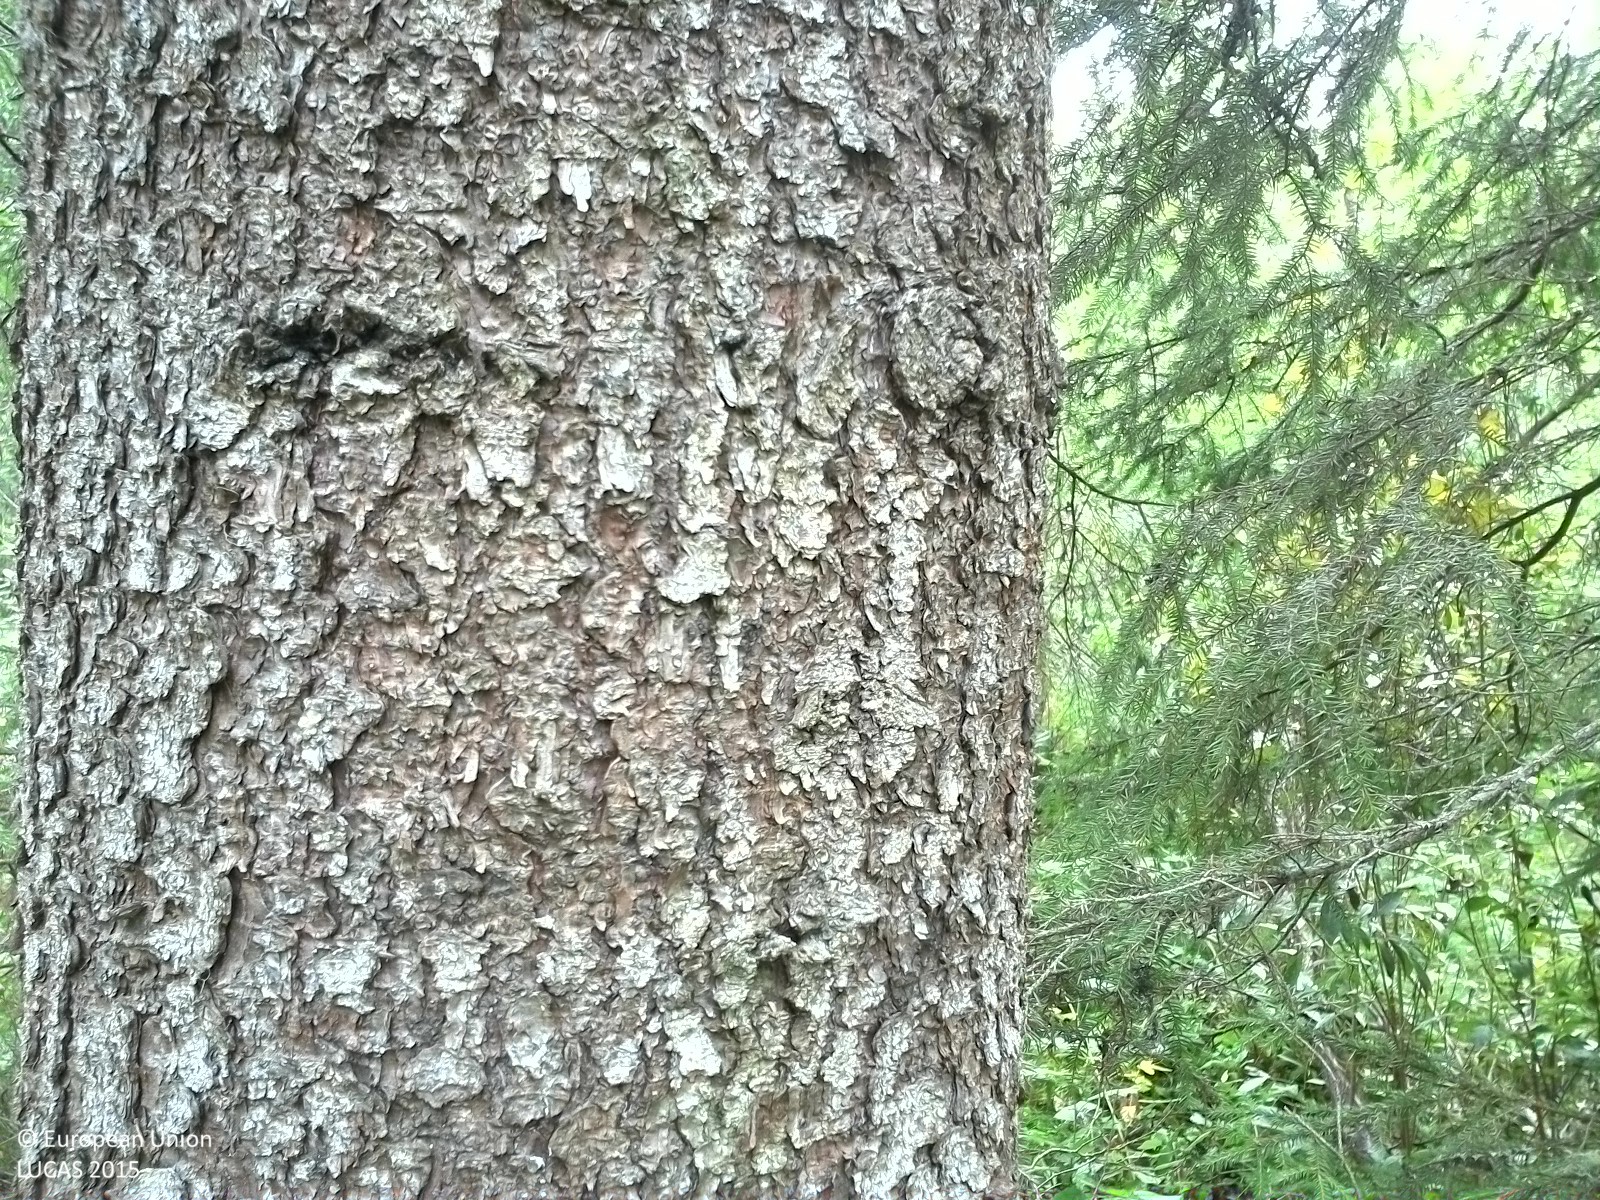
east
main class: Woodland
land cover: Spruce dominated coniferous woodland
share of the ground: > 75 %
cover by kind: coniferous forest trees 80 %, herbaceous plants 10 %, broadleaved forest trees 5 %, shrubs 5 %
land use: Forestry
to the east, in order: Spruce dominated coniferous woodland; Broadleaved woodland; Ditches and canals; Other mixed woodland; Shrubland without tree cover; Broadleaved woodland; Ditches and canals; Broadleaved woodland; Other coniferous woodland
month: August
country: SE
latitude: 62.4225
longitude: 16.3885
